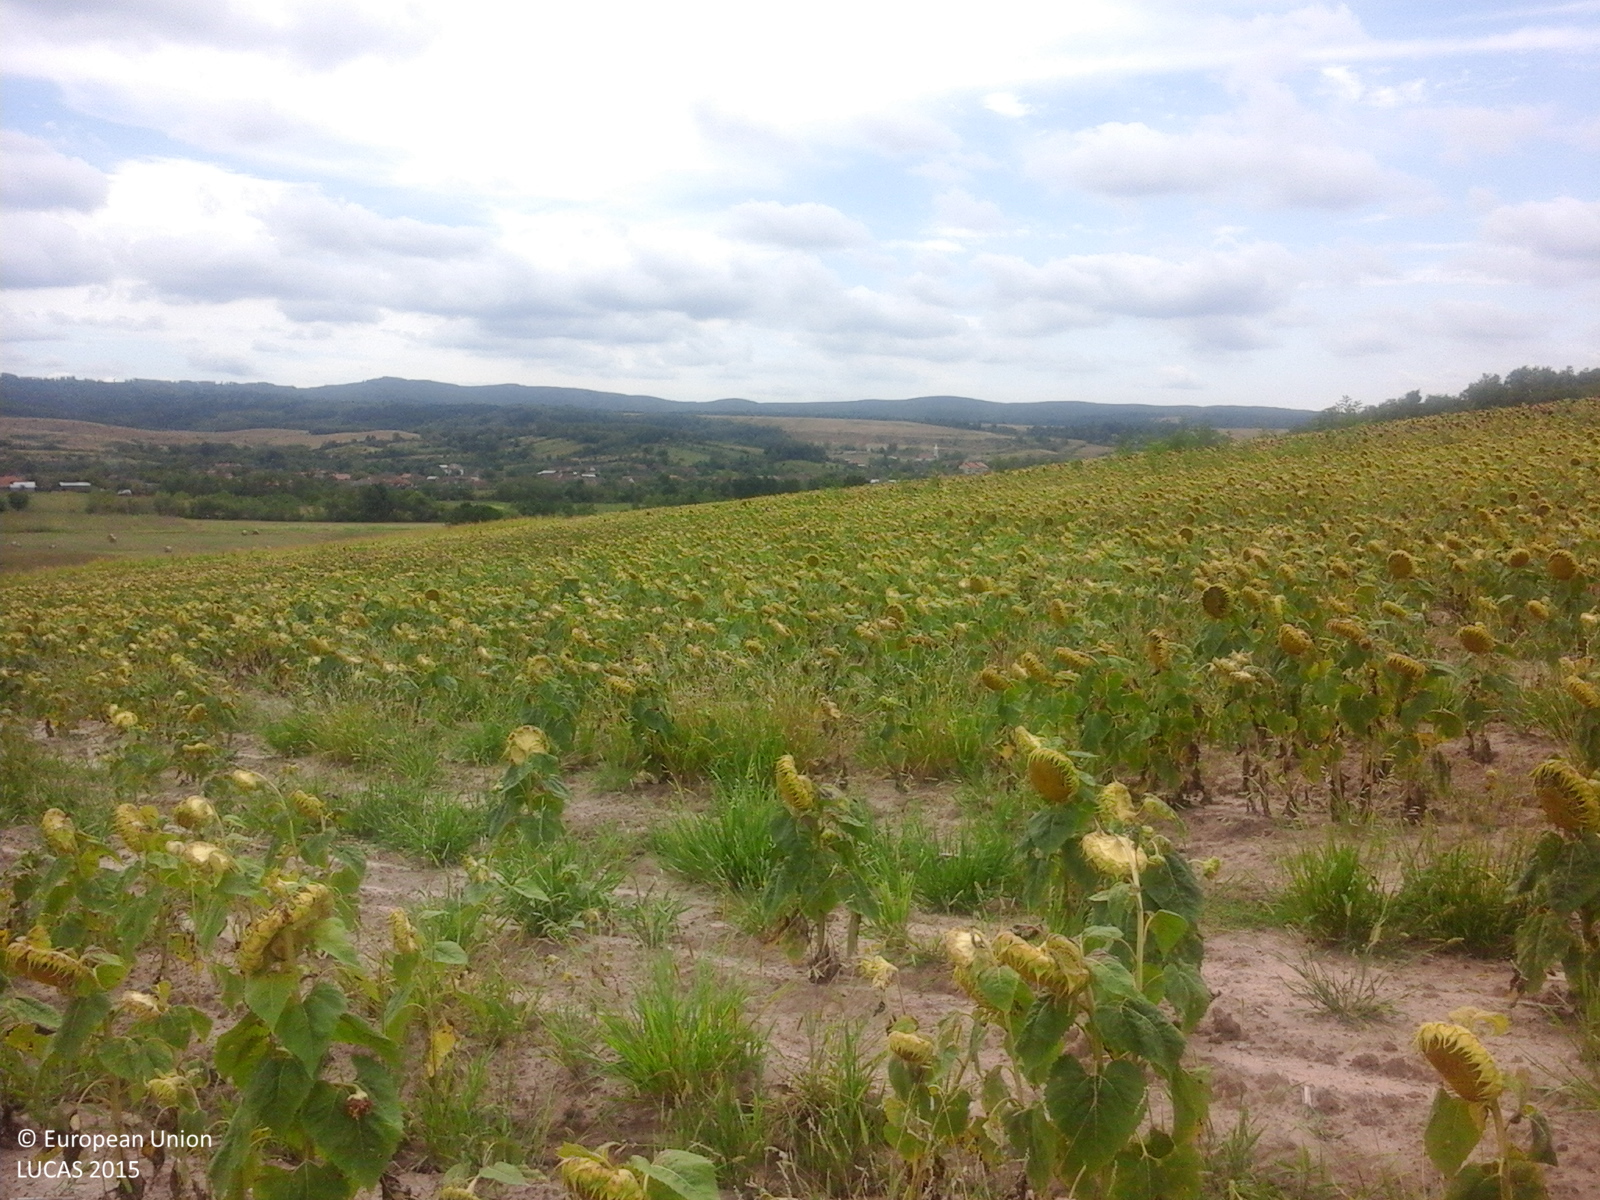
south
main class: Cropland
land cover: Sunflower
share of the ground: 50 - 75 %
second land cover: Spontaneously vegetated surfaces
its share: 25 - 50 %
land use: Agriculture (excluding fallow land and kitchen gardens)
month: August
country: RO
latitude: 45.3117
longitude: 21.6529
